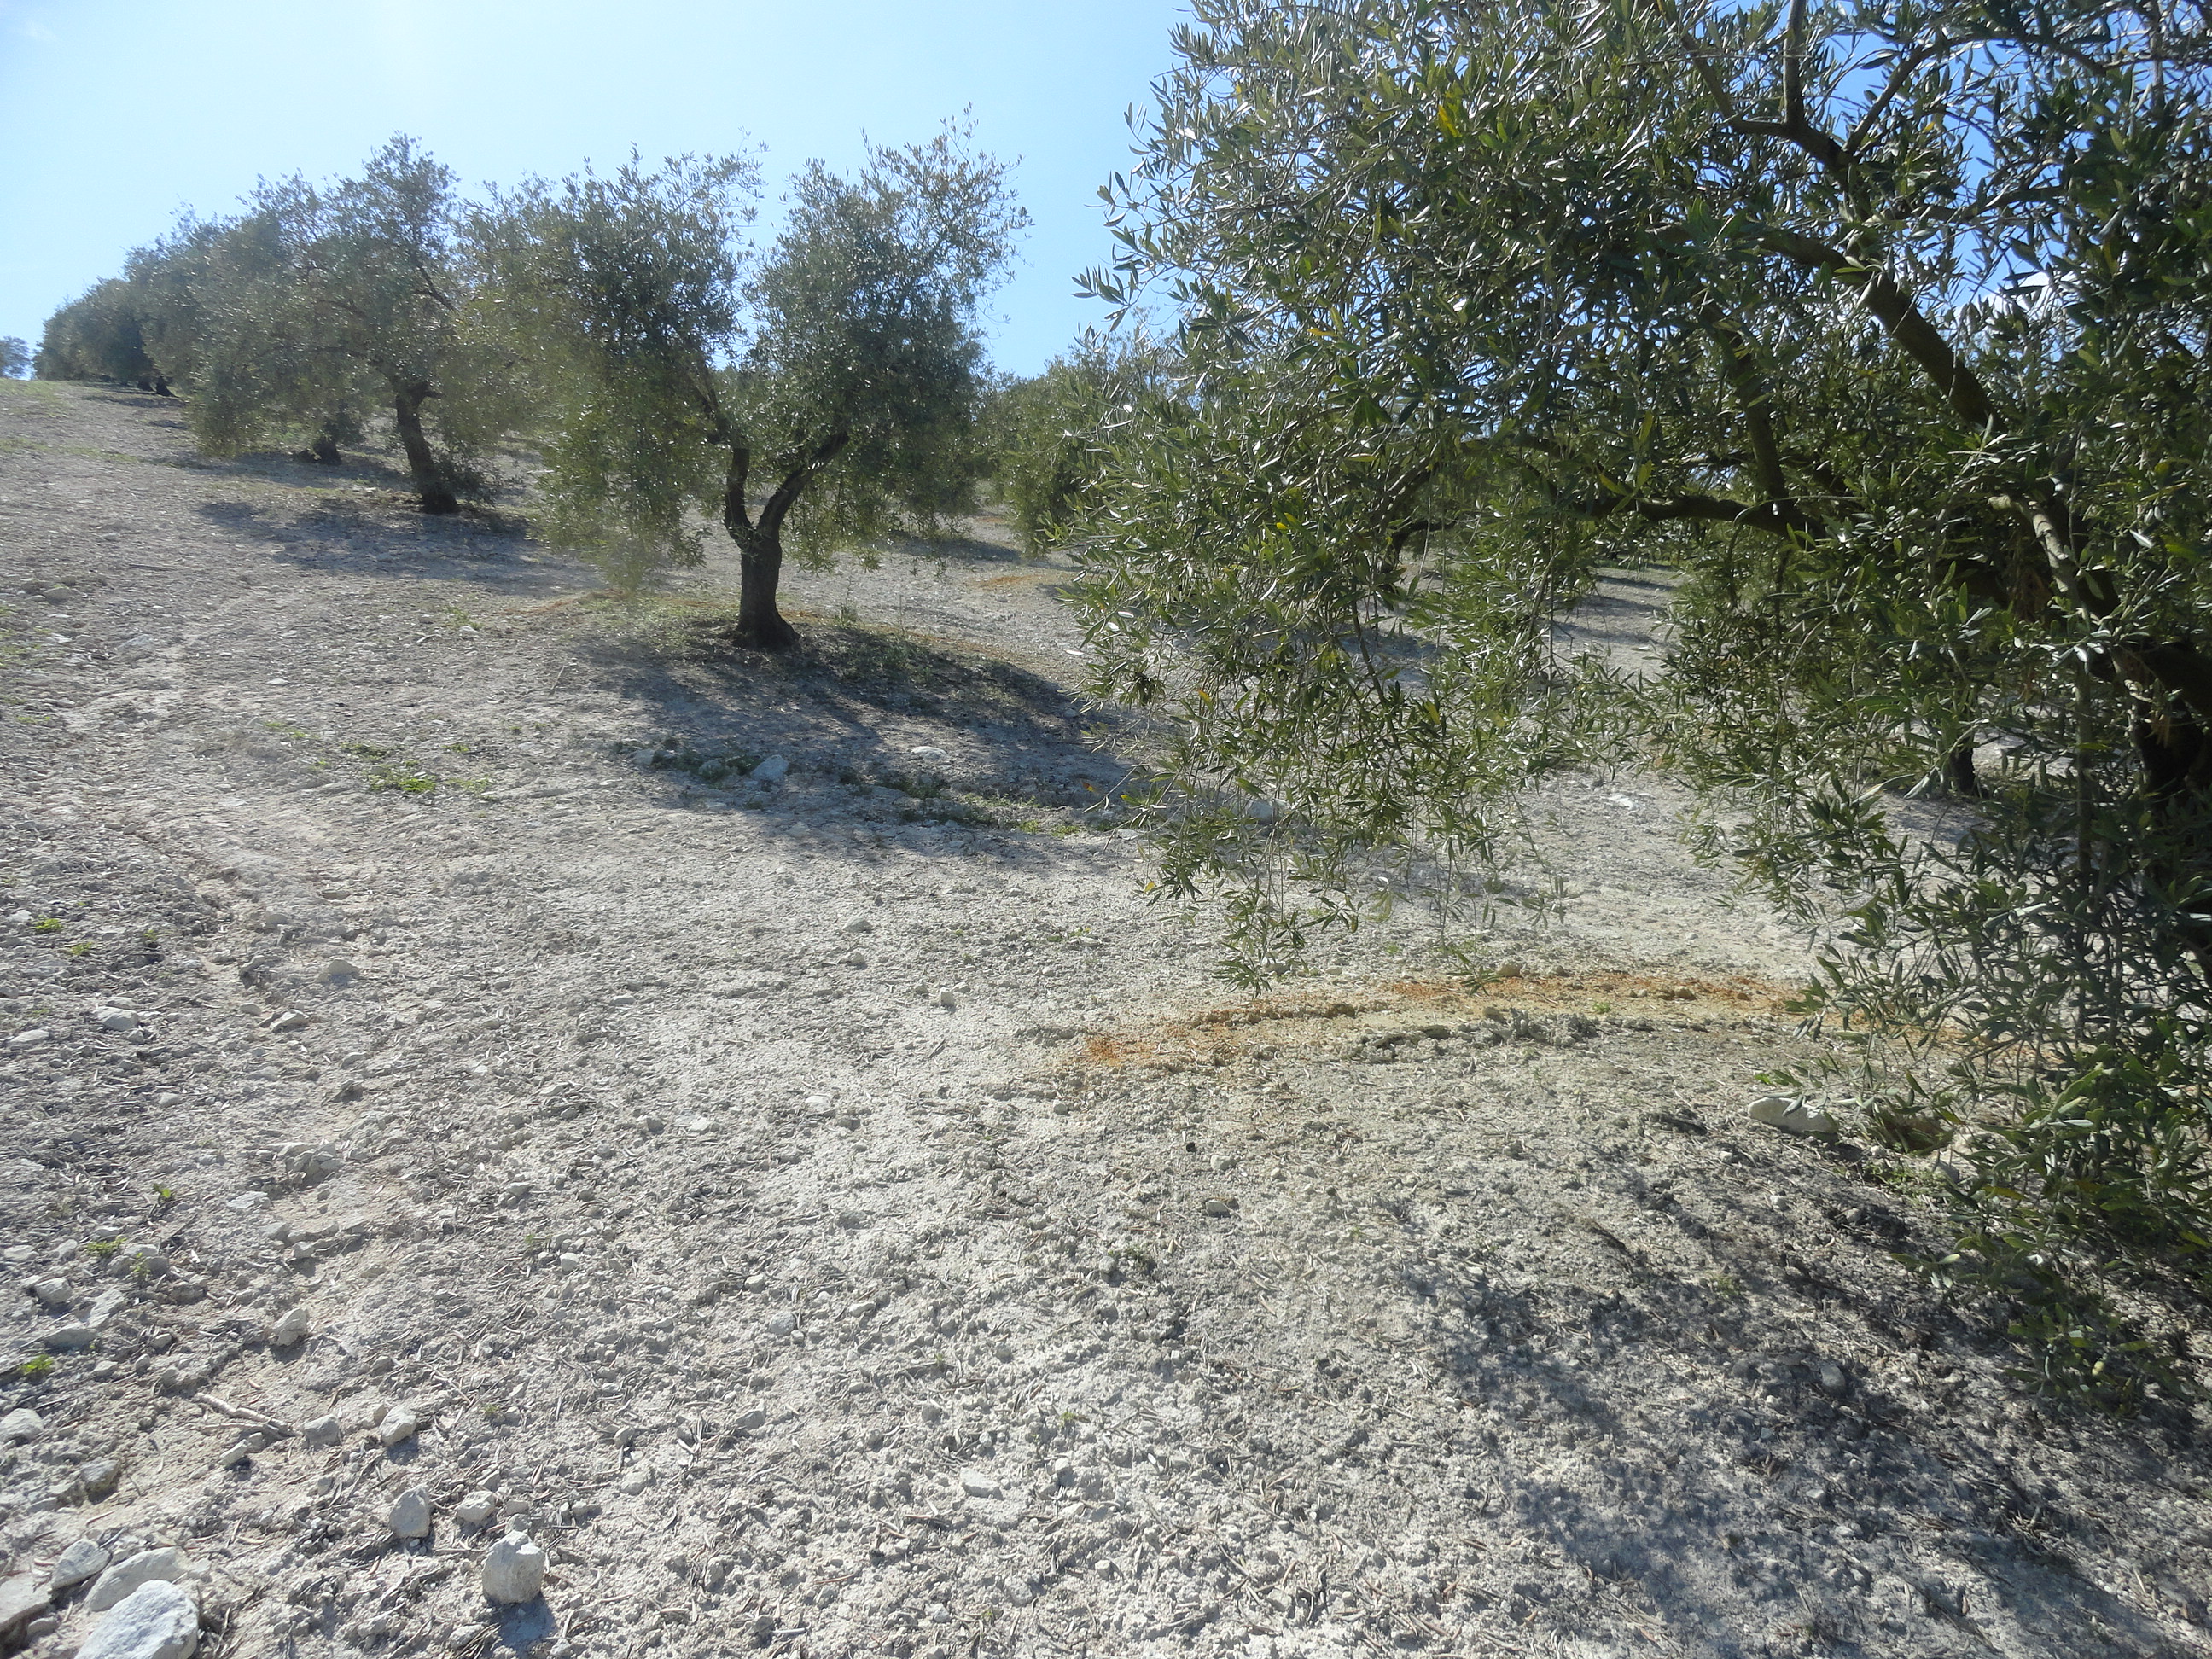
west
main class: Cropland
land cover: Olive groves
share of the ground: 50 - 75 %
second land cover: Other bare soil
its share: > 75 %
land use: Agriculture (excluding fallow land and kitchen gardens)
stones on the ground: 10 - 25 %
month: April
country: ES
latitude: 37.5341
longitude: -4.4787
